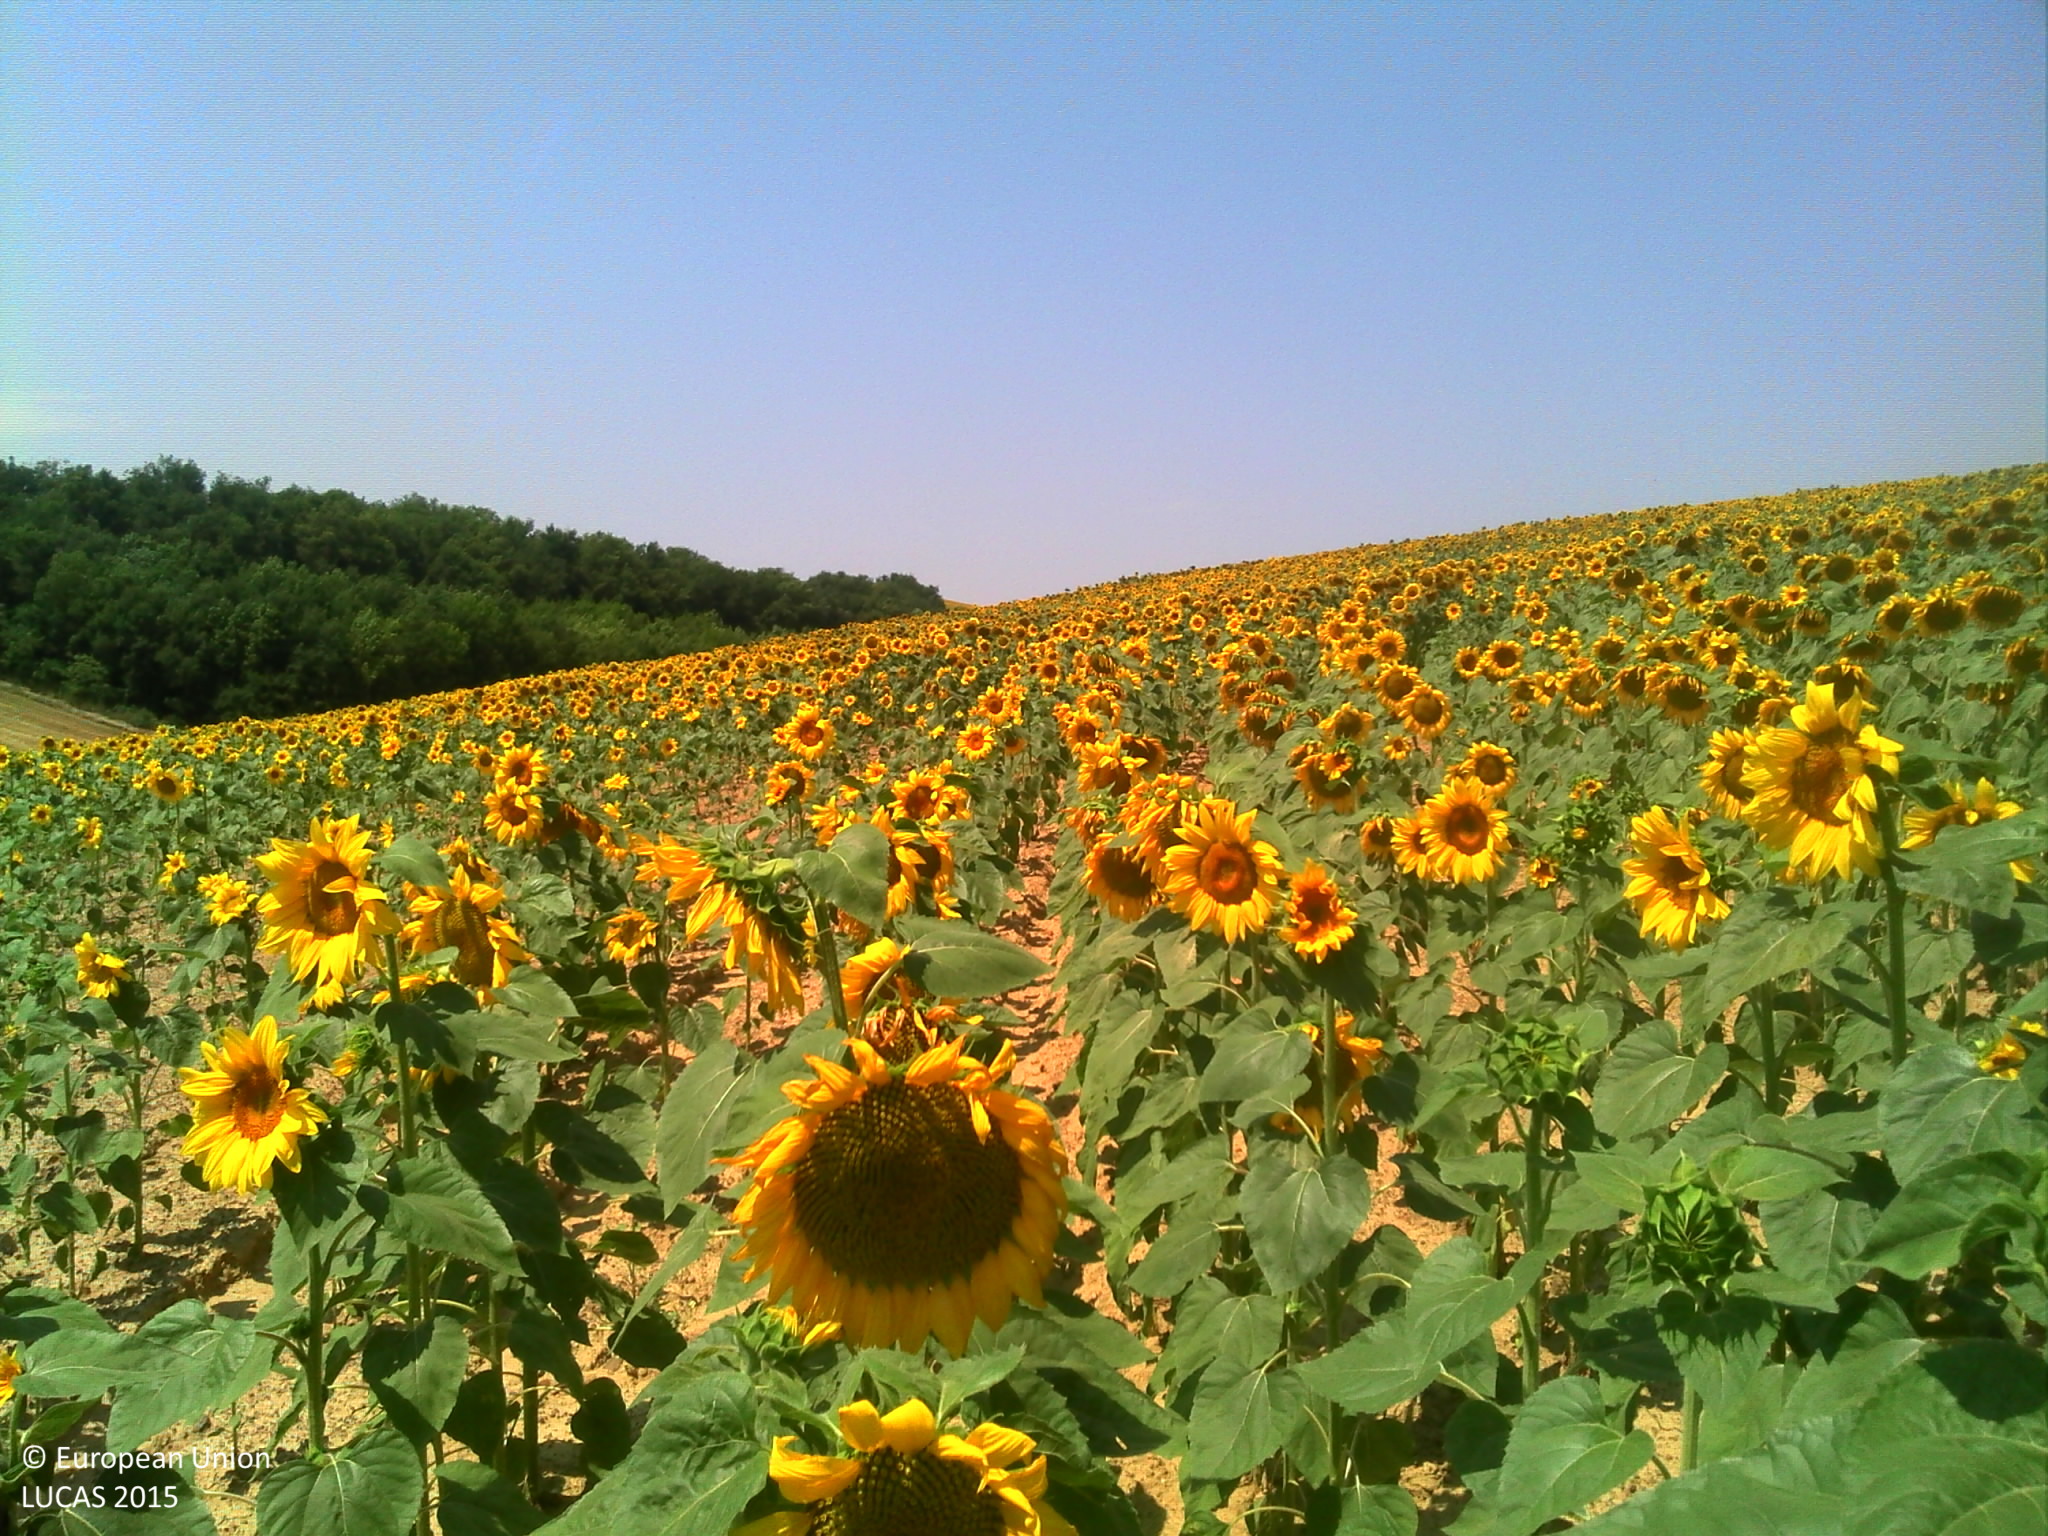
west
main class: Cropland
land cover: Sunflower
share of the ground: > 75 %
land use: Agriculture (excluding fallow land and kitchen gardens)
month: July
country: FR
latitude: 43.3227
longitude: 0.9877
